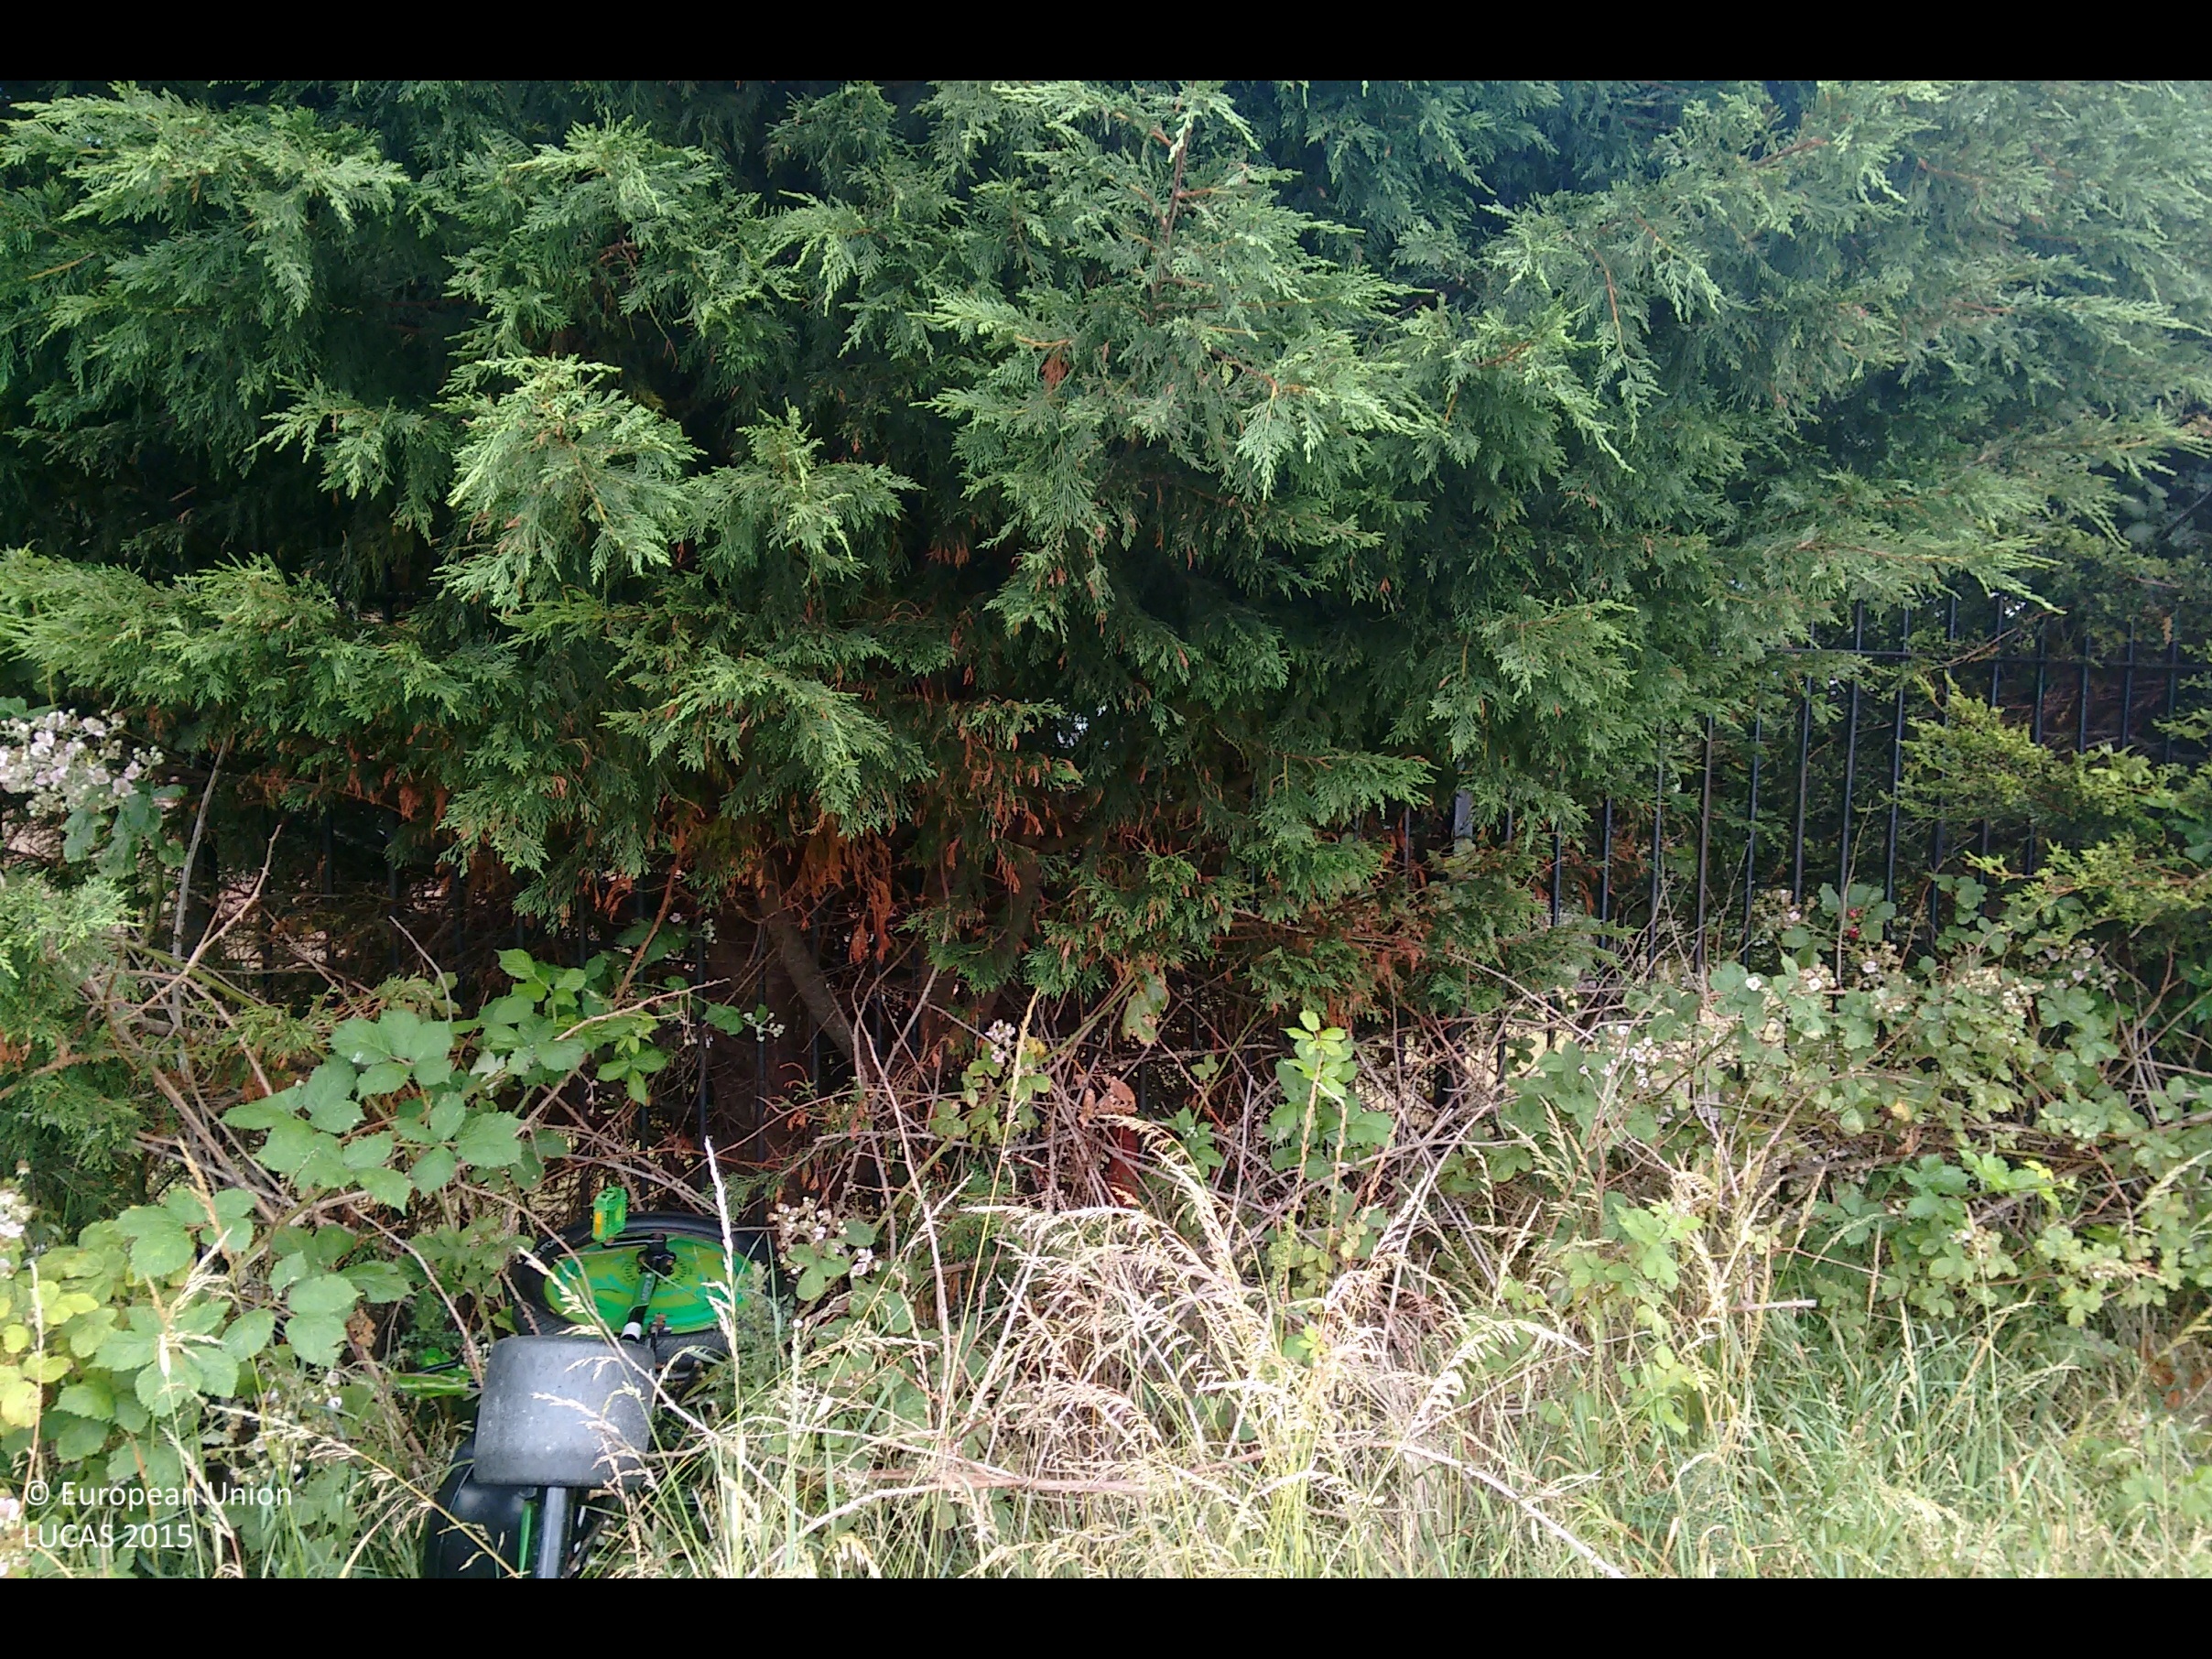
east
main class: Grassland
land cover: Grassland with sparse tree/shrub cover
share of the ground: > 75 %
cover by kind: herbaceous plants 95 %, broadleaved forest trees 5 %
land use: Amenities, museums, leisure
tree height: > 5 m
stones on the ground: < 10 %
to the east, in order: Grassland with sparse tree/shrub cover; Fences; Artificial constructions in urban areas; Grassland without tree/shrub cover; Artificial constructions in urban areas; Grassland without tree/shrub cover; Artificial constructions in urban areas
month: July
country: GB
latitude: 53.3777
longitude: -2.7725
